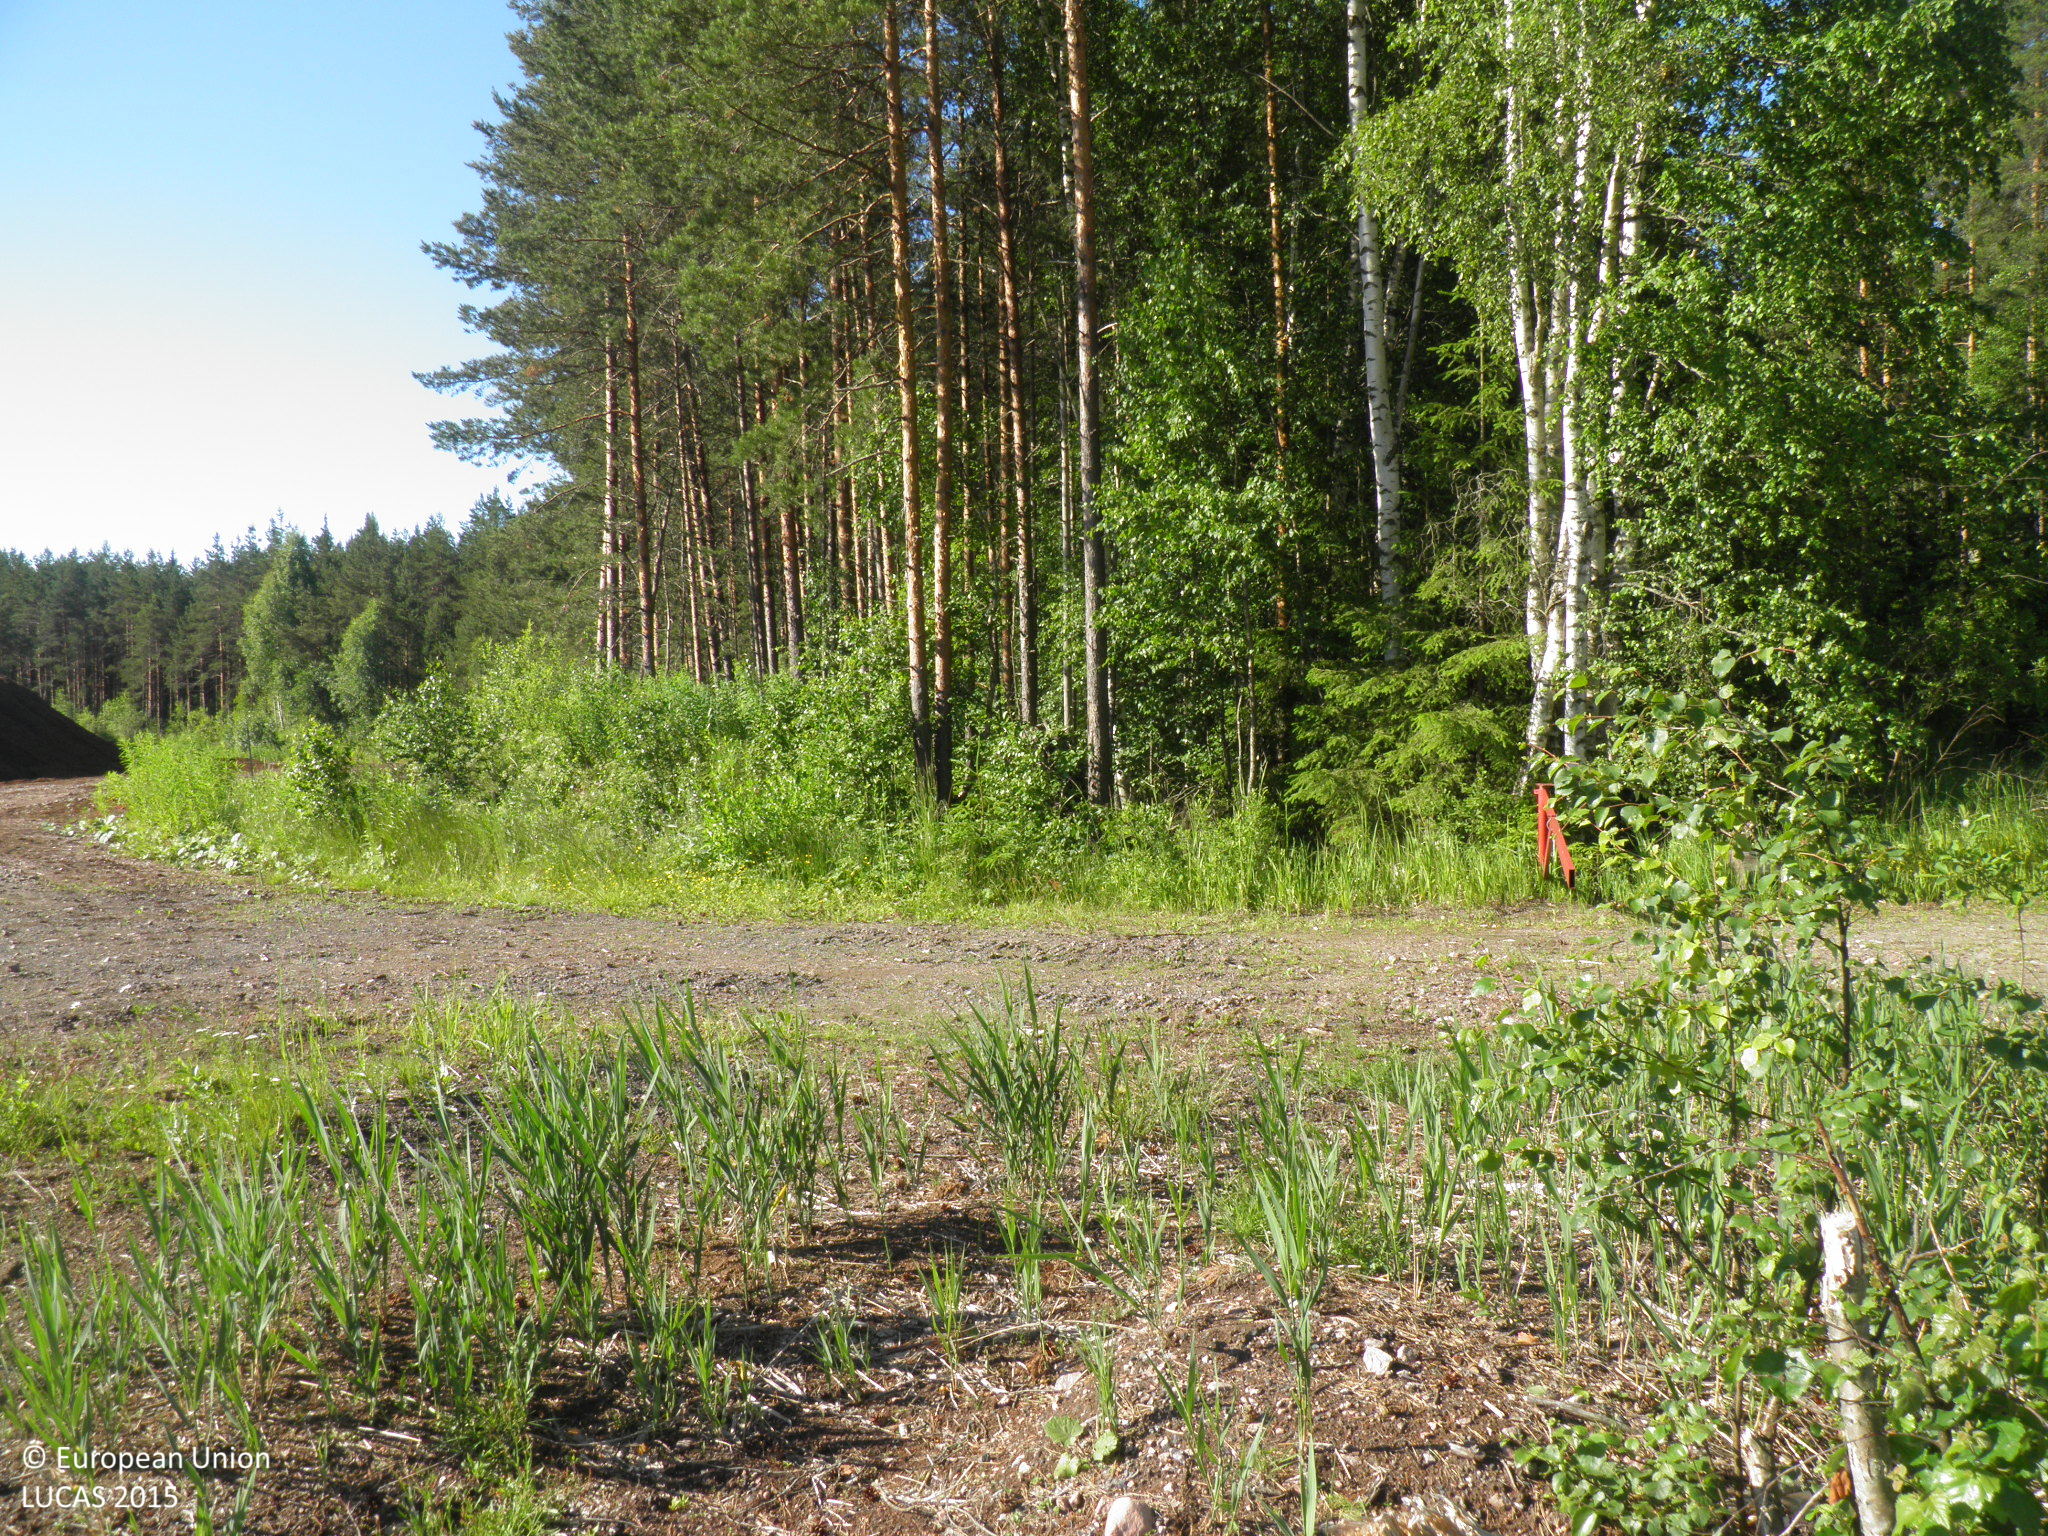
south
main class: Grassland
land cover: Spontaneously vegetated surfaces
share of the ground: 10 - 25 %
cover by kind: unconsolidated bare surface 80 %, herbaceous plants 15 %, shrubs 5 %
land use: Forestry
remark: Clear cut
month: July
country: FI
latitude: 60.5465
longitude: 22.7817
